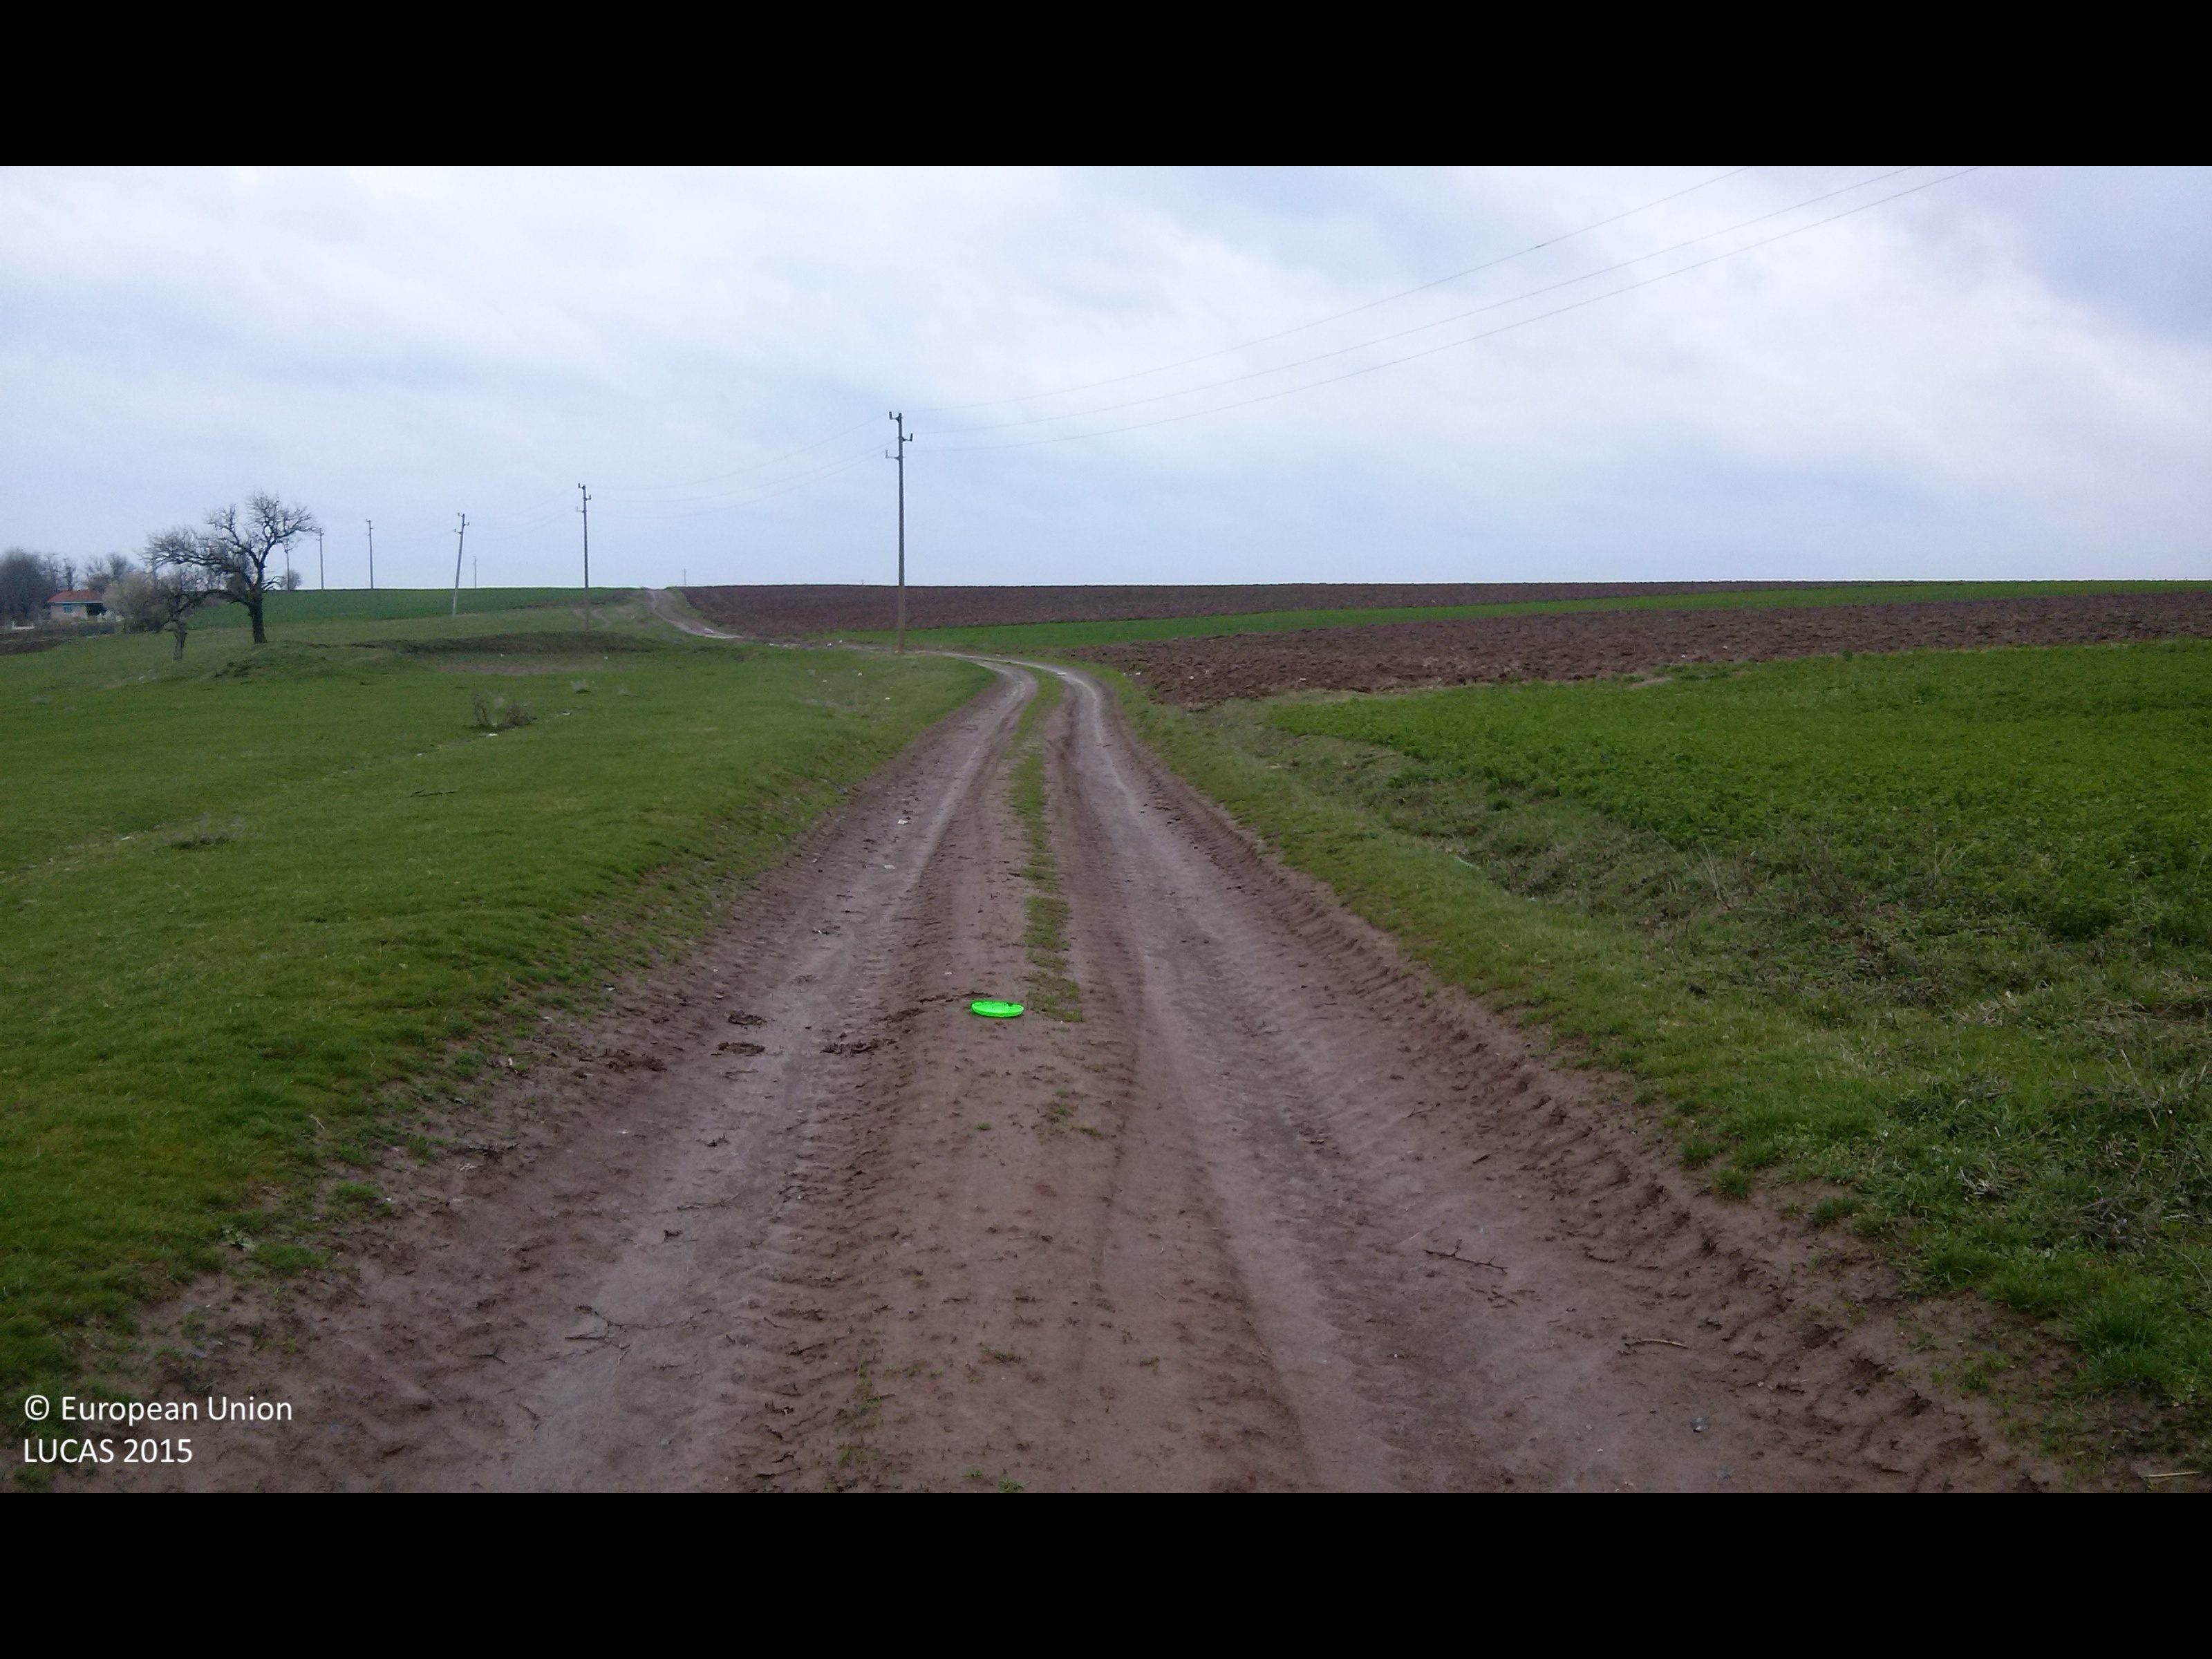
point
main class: Cropland
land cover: Common wheat
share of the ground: > 75 %
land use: Agriculture (excluding fallow land and kitchen gardens)
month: June
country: BG
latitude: 43.6552
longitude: 26.7654
